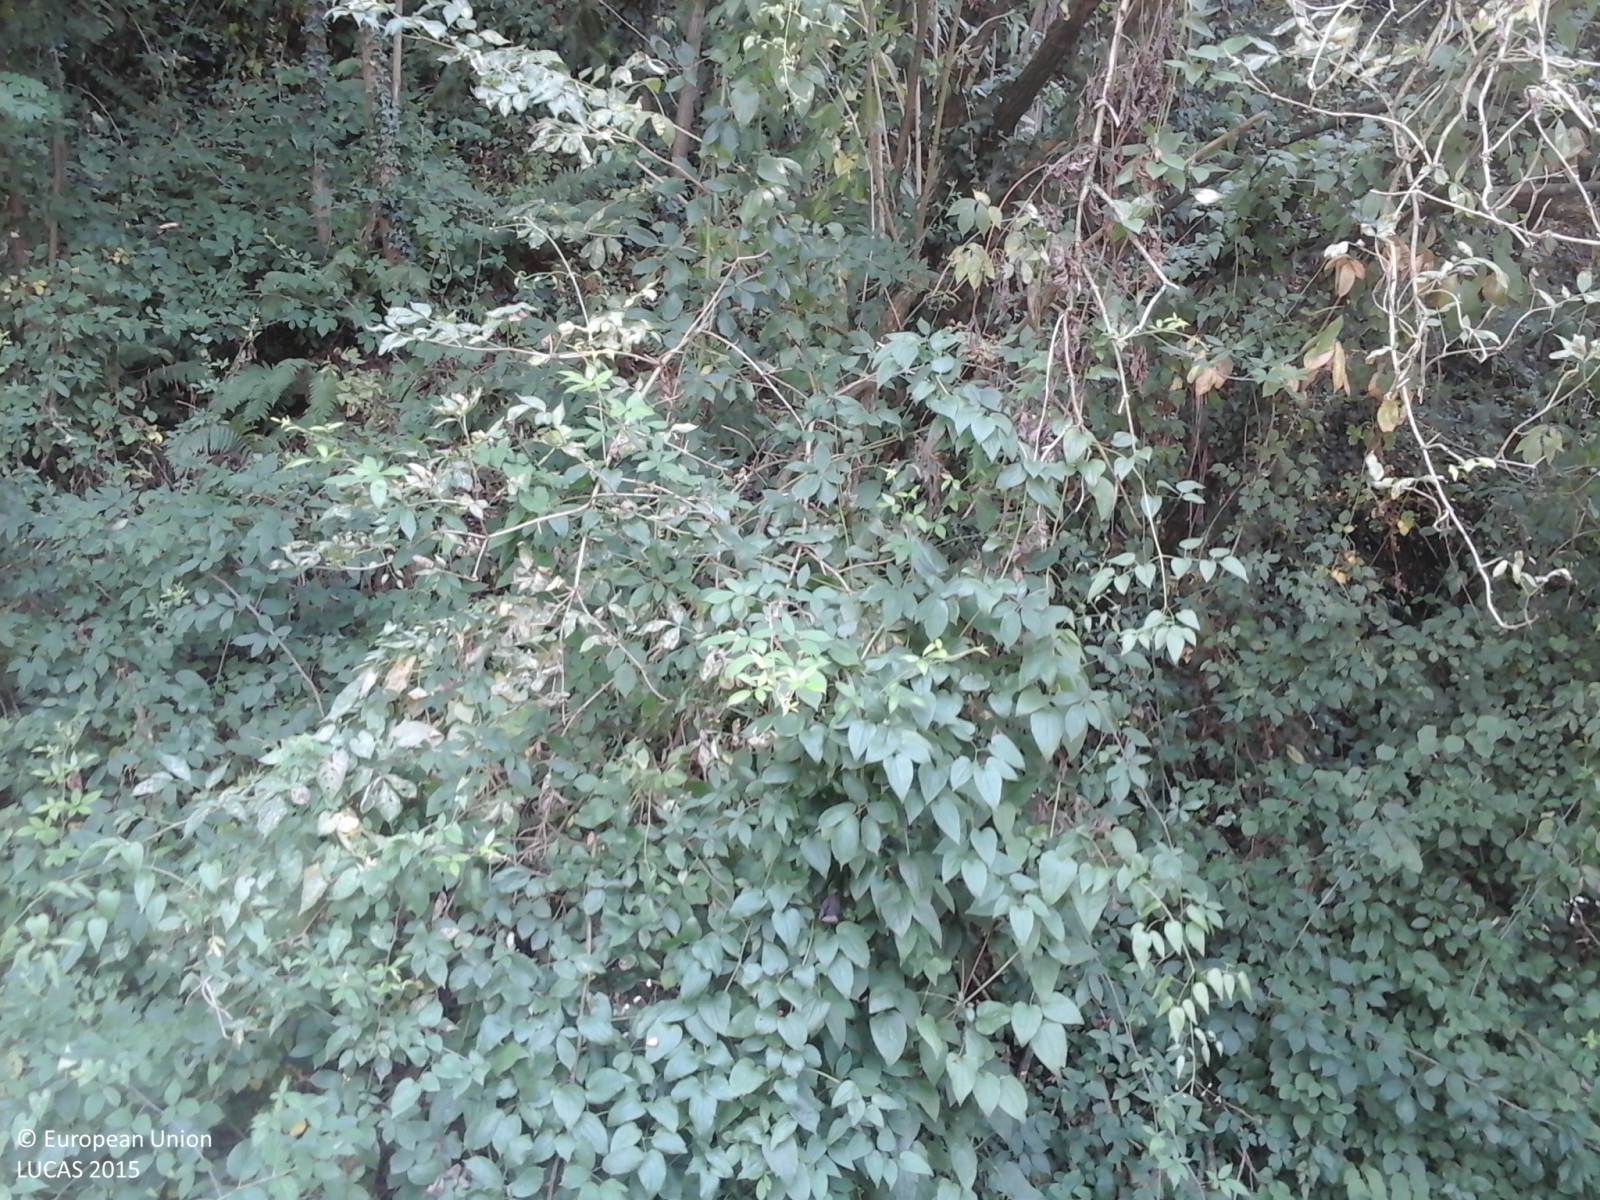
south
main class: Grassland
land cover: Grassland without tree/shrub cover
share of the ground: 50 - 75 %
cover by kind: herbaceous plants 95 %, shrubs 5 %
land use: Residential
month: August
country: IT
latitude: 43.9501
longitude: 10.8576
